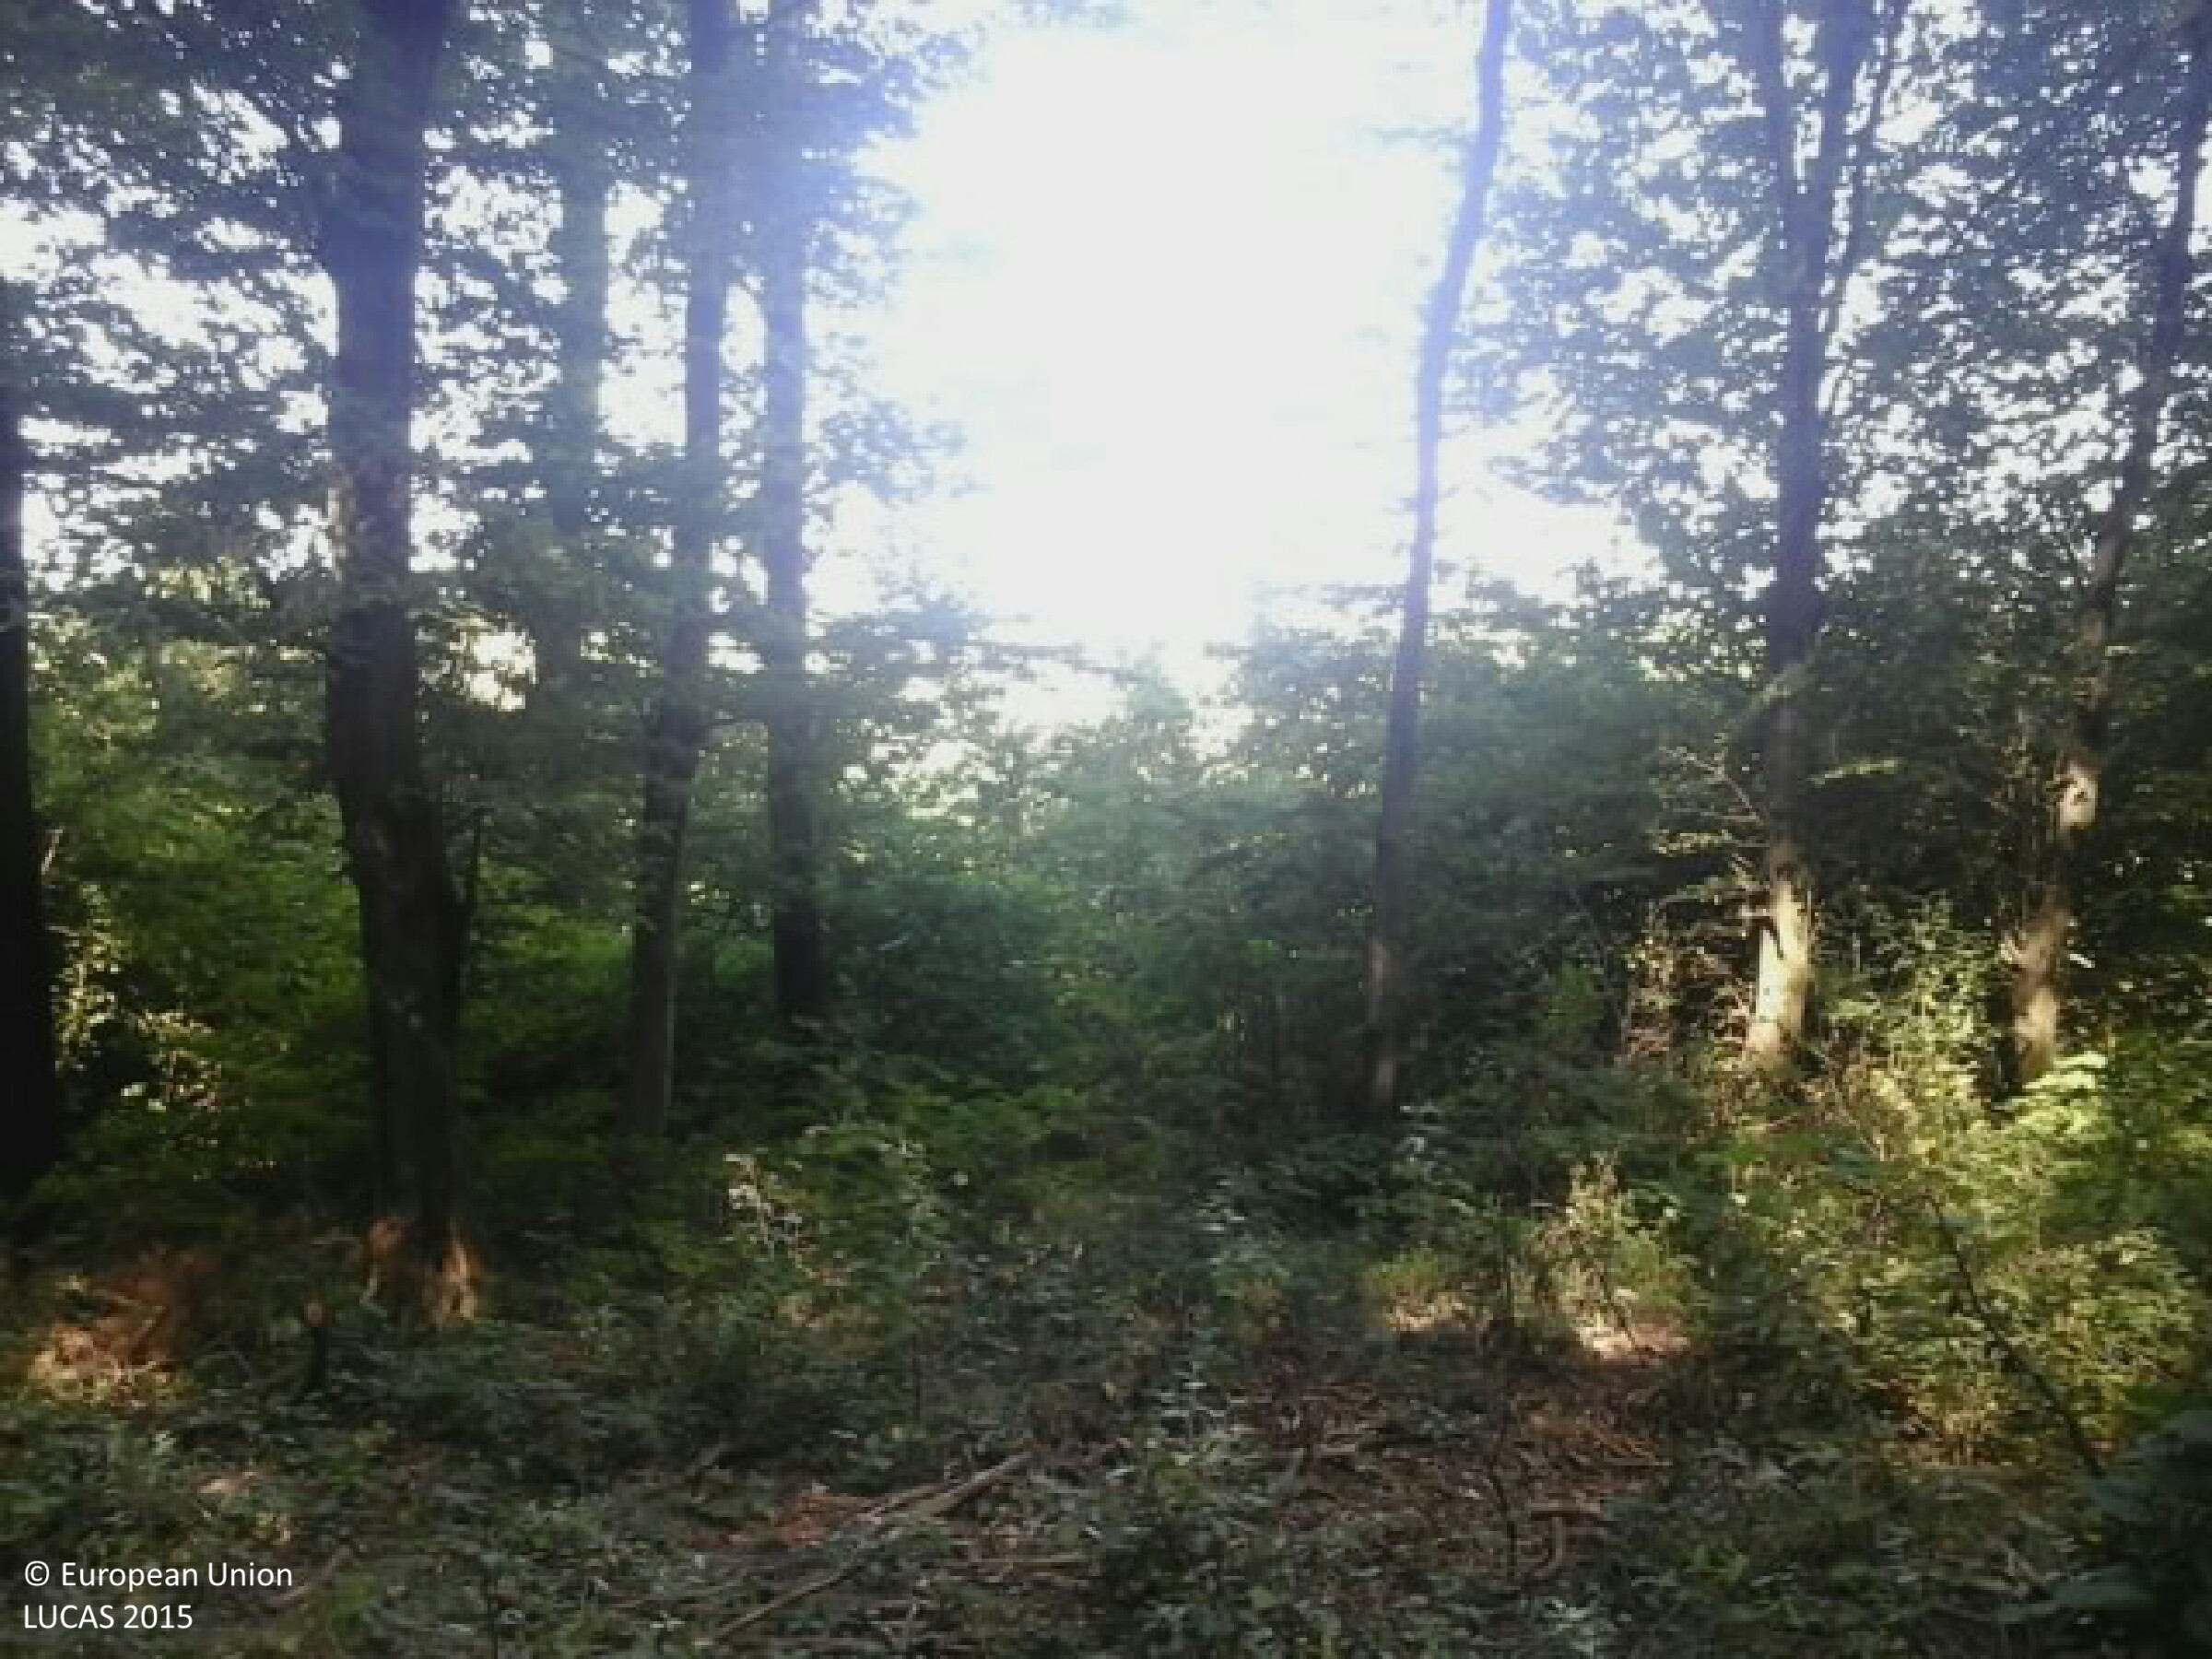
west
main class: Woodland
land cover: Broadleaved woodland
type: beech forest
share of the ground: > 75 %
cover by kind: broadleaved forest trees 95 %, herbaceous plants 5 %
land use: Forestry
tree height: < 5 m
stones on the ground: < 10 %
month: August
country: HU
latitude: 46.4106
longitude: 18.0338
